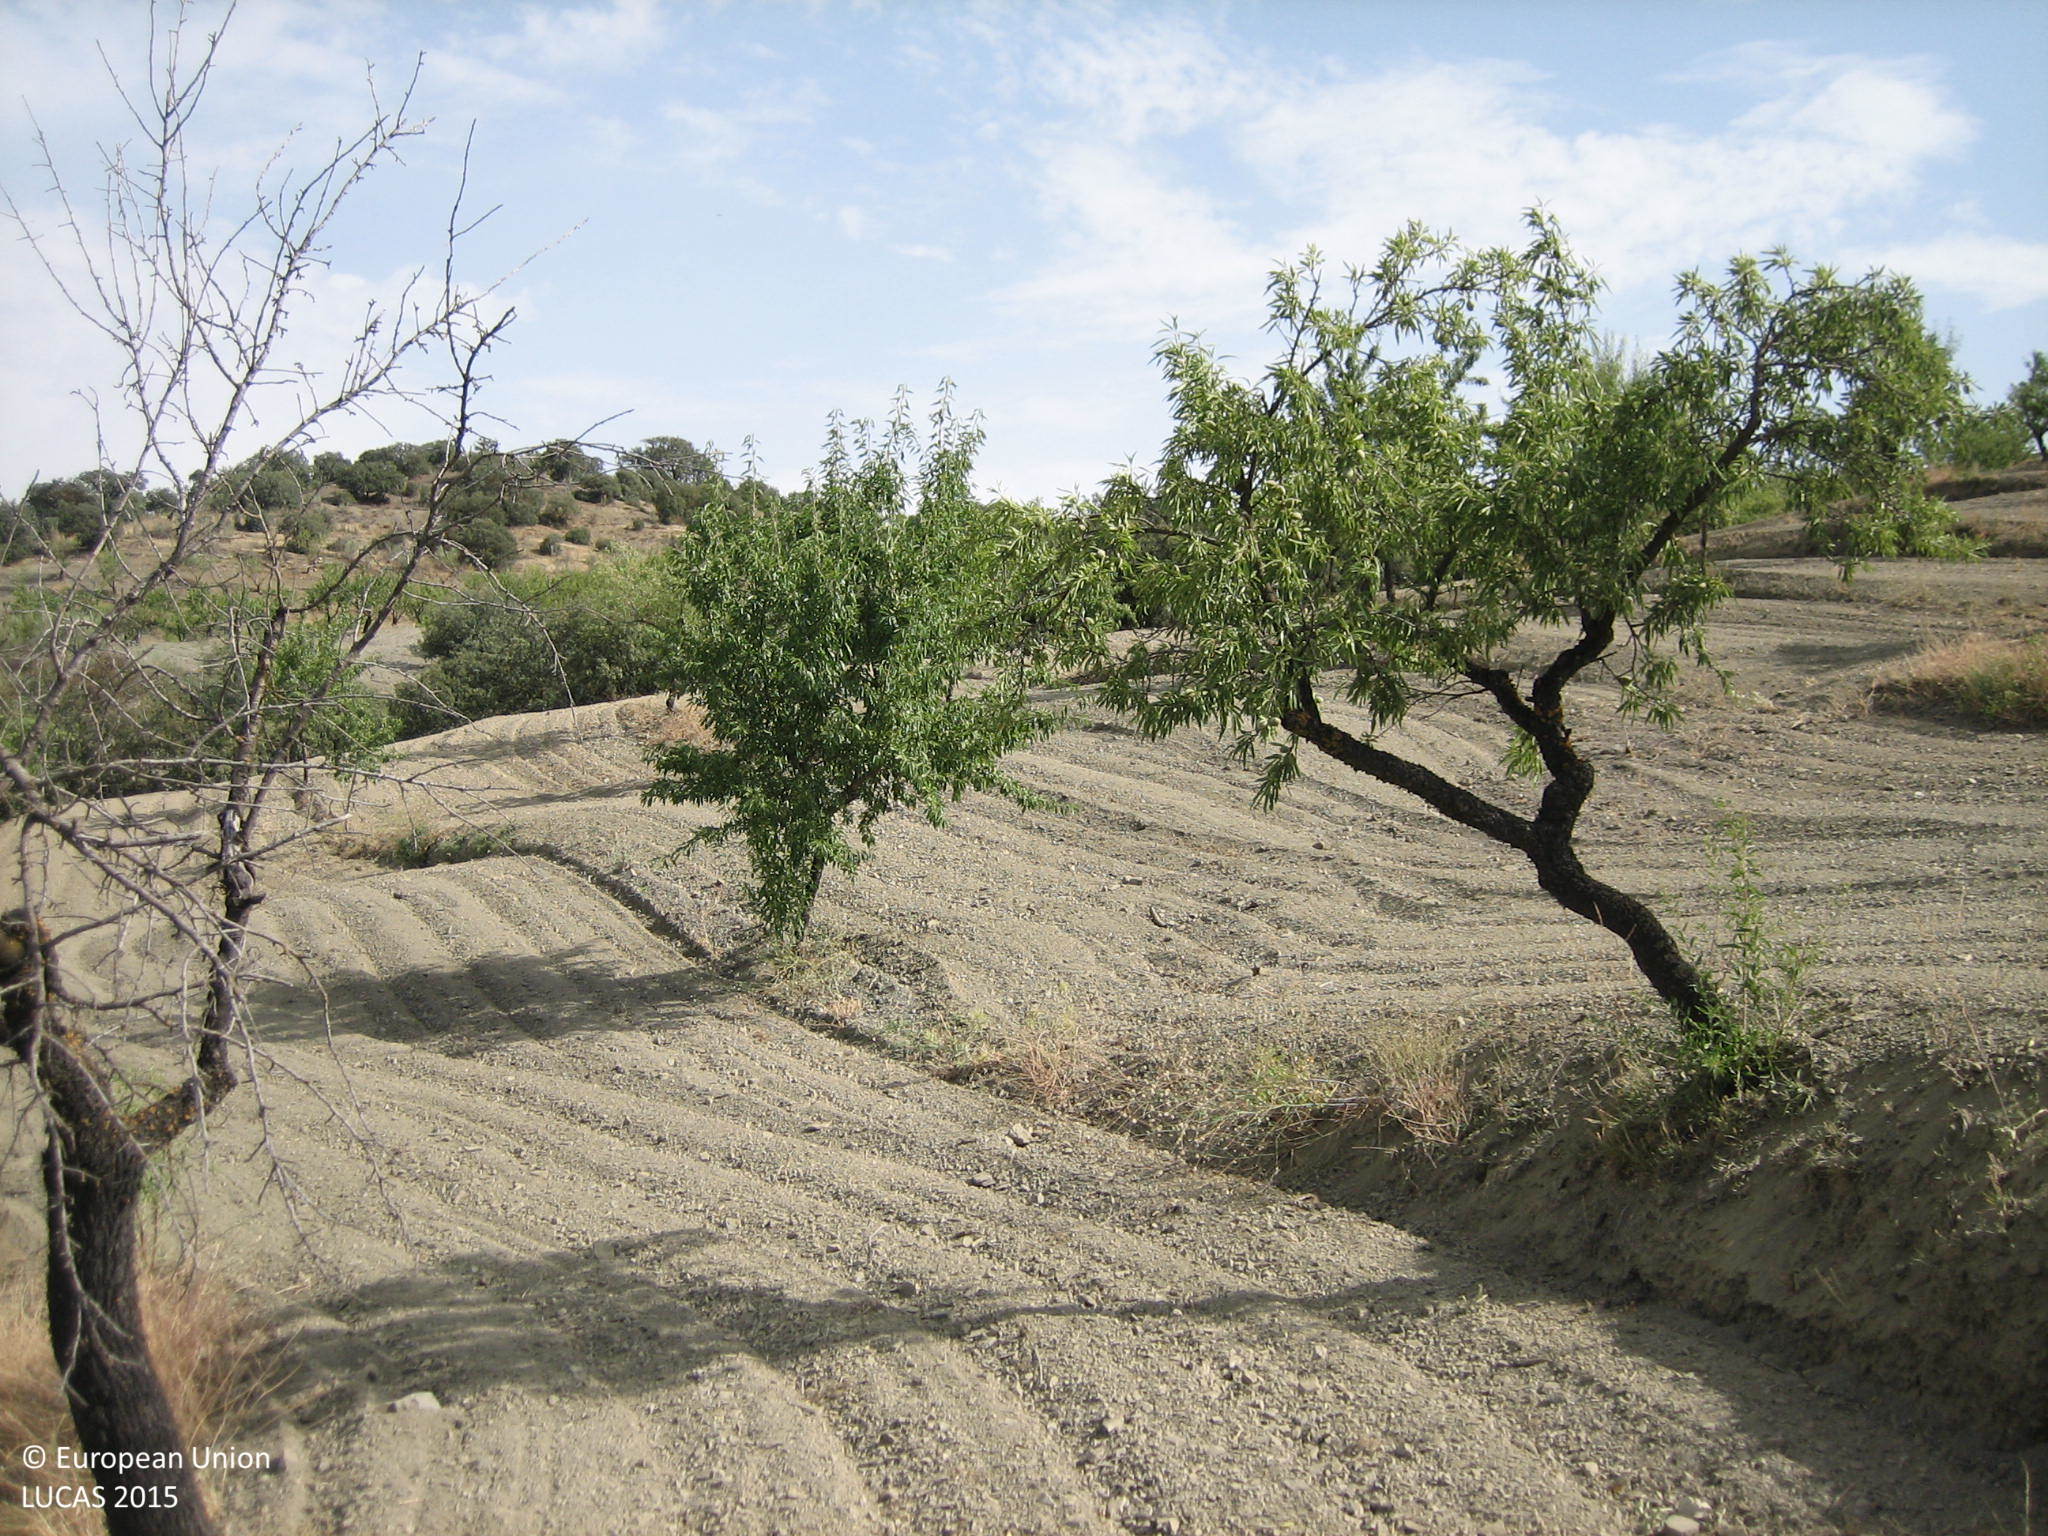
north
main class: Cropland
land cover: Nuts trees
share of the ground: 10 - 25 %
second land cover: Other bare soil
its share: > 75 %
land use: Agriculture (excluding fallow land and kitchen gardens)
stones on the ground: < 10 %
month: July
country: ES
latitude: 37.5398
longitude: -2.2409
